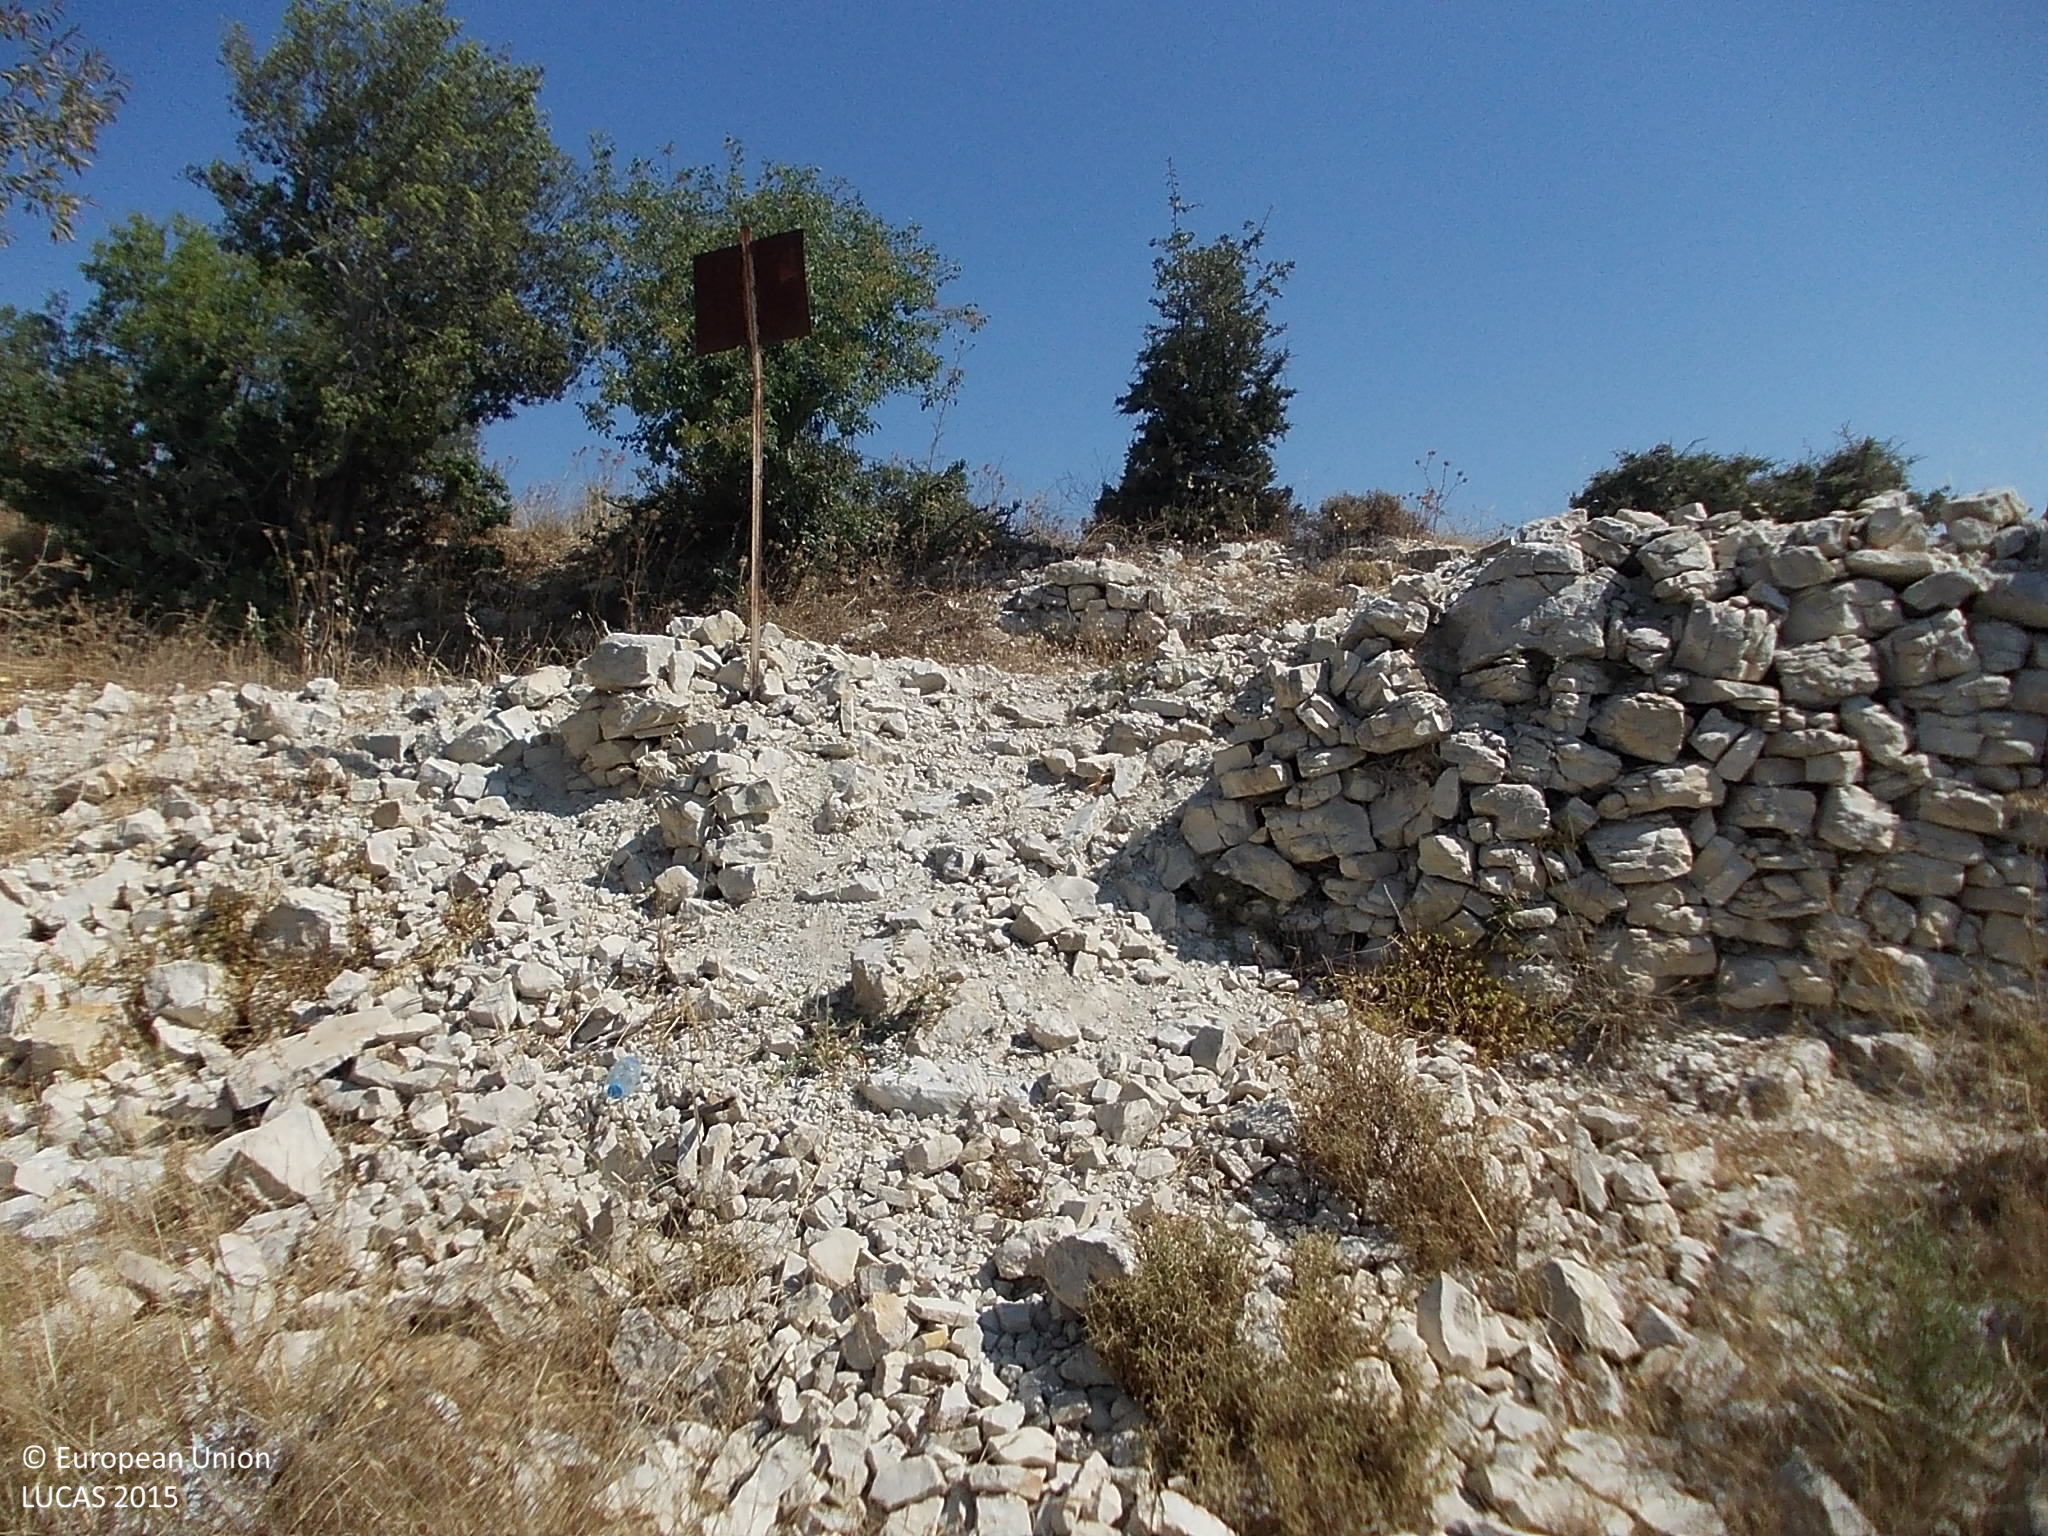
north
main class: Cropland
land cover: Nuts trees
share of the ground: 10 - 25 %
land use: Agriculture (excluding fallow land and kitchen gardens)
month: July
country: CY
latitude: 34.7838
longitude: 32.7452
